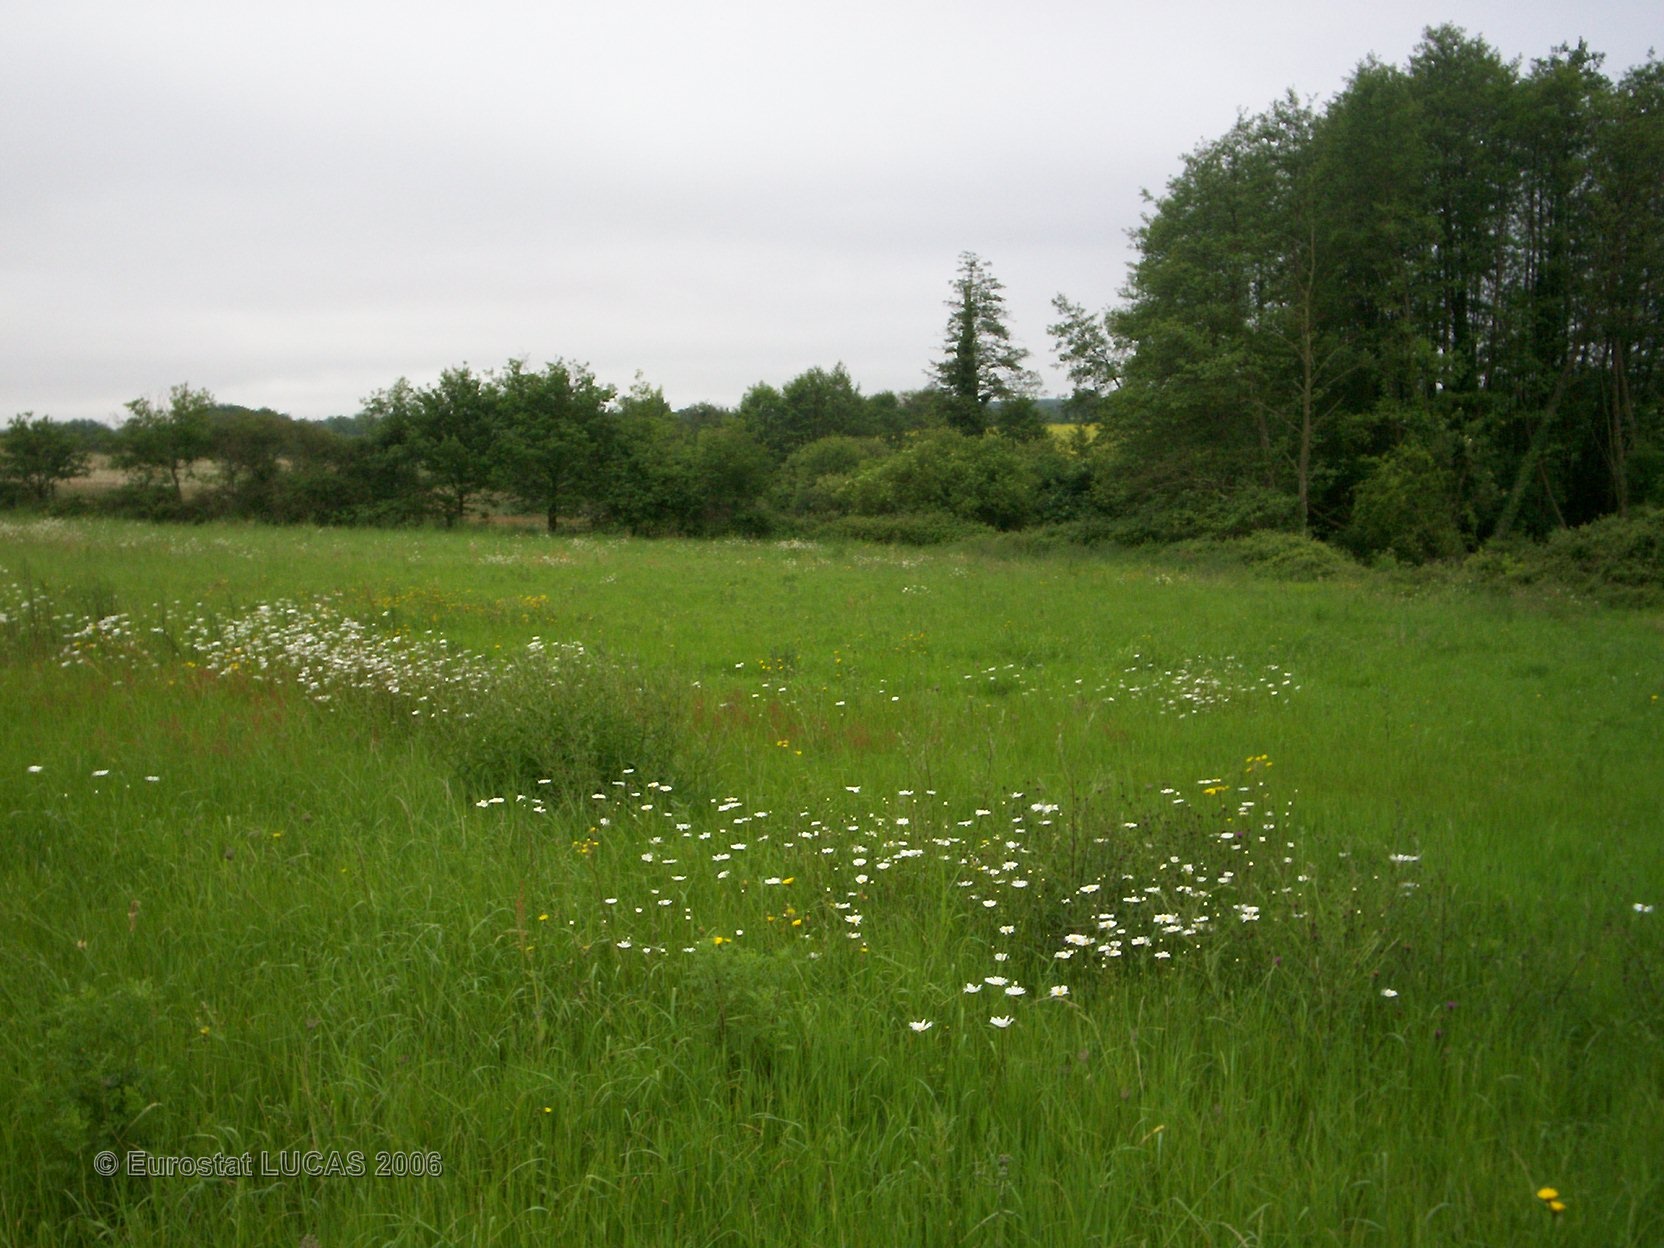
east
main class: Grassland
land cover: Grassland without tree/shrub cover
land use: Agriculture (excluding fallow land and kitchen gardens)
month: May
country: FR
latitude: 47.4953
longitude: -1.4714
